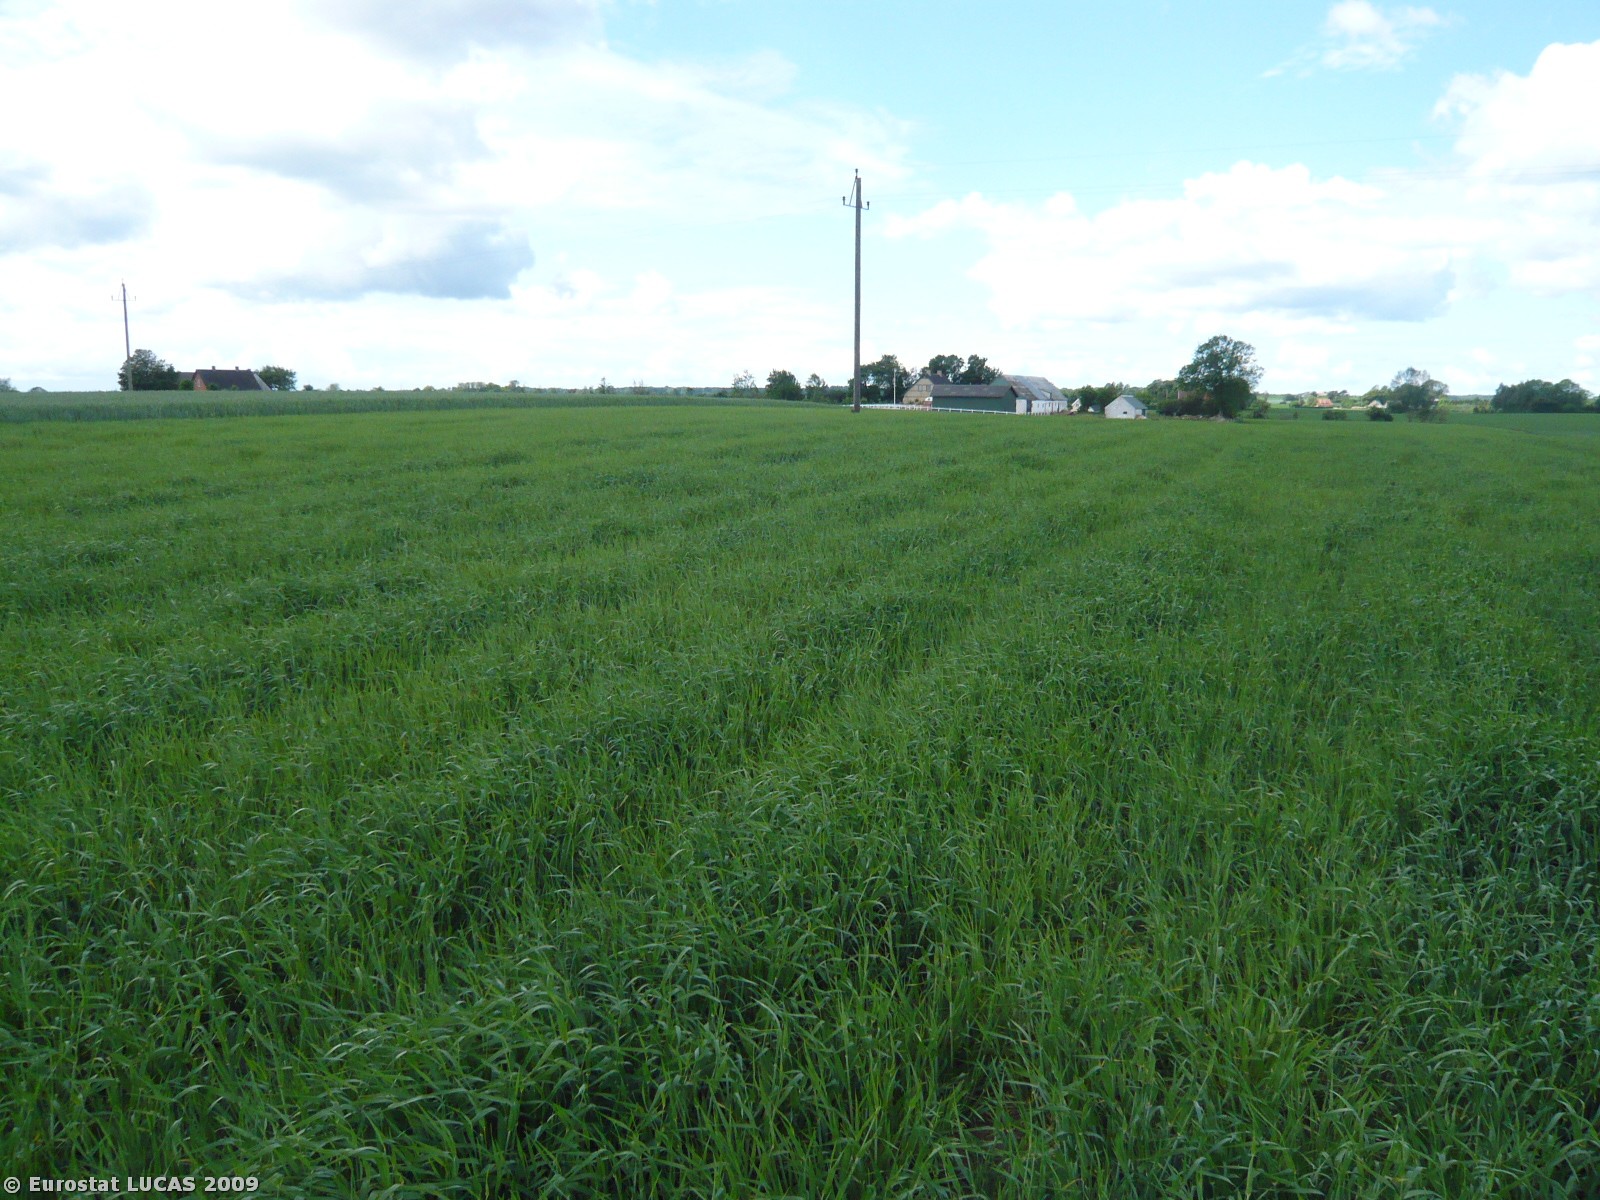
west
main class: Cropland
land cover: Barley
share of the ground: > 75 %
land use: Agriculture (excluding fallow land and kitchen gardens)
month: June
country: DK
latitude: 55.2255
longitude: 11.5552
